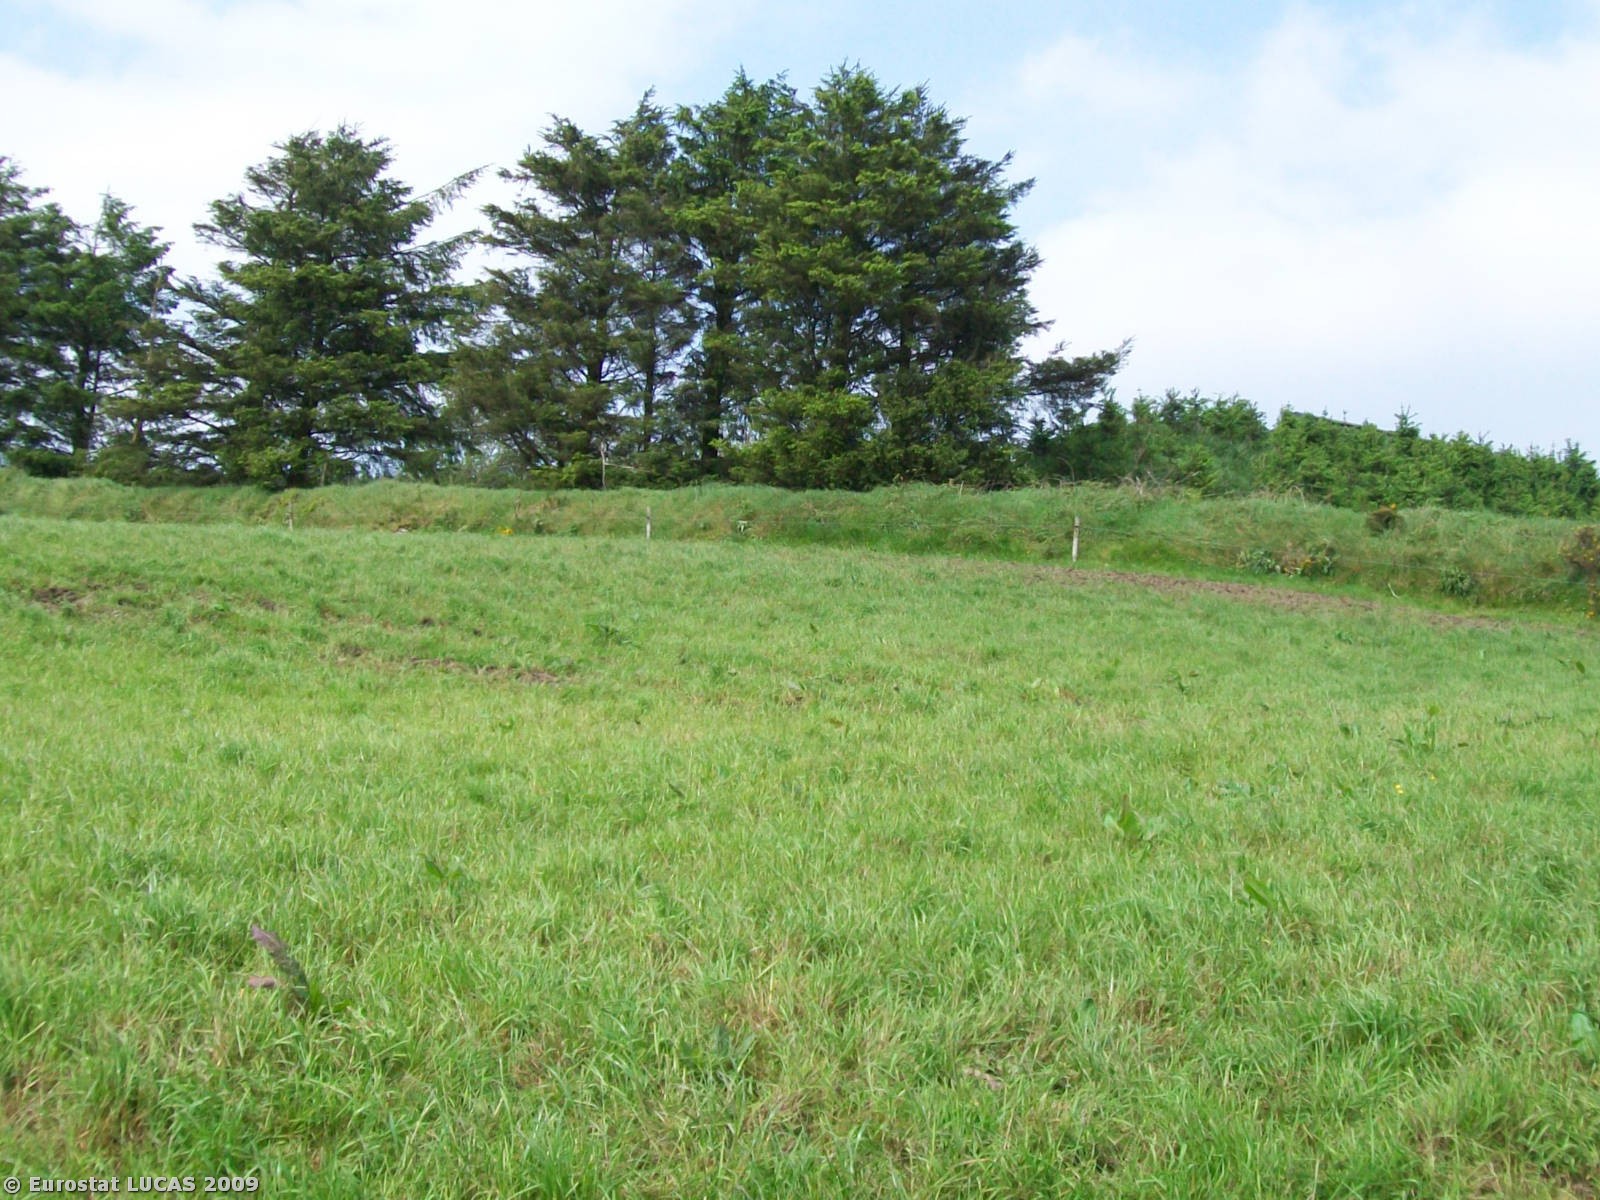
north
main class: Grassland
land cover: Grassland without tree/shrub cover
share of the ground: > 75 %
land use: Agriculture (excluding fallow land and kitchen gardens)
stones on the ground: < 10 %
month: May
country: IE
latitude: 52.0222
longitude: -8.7854
